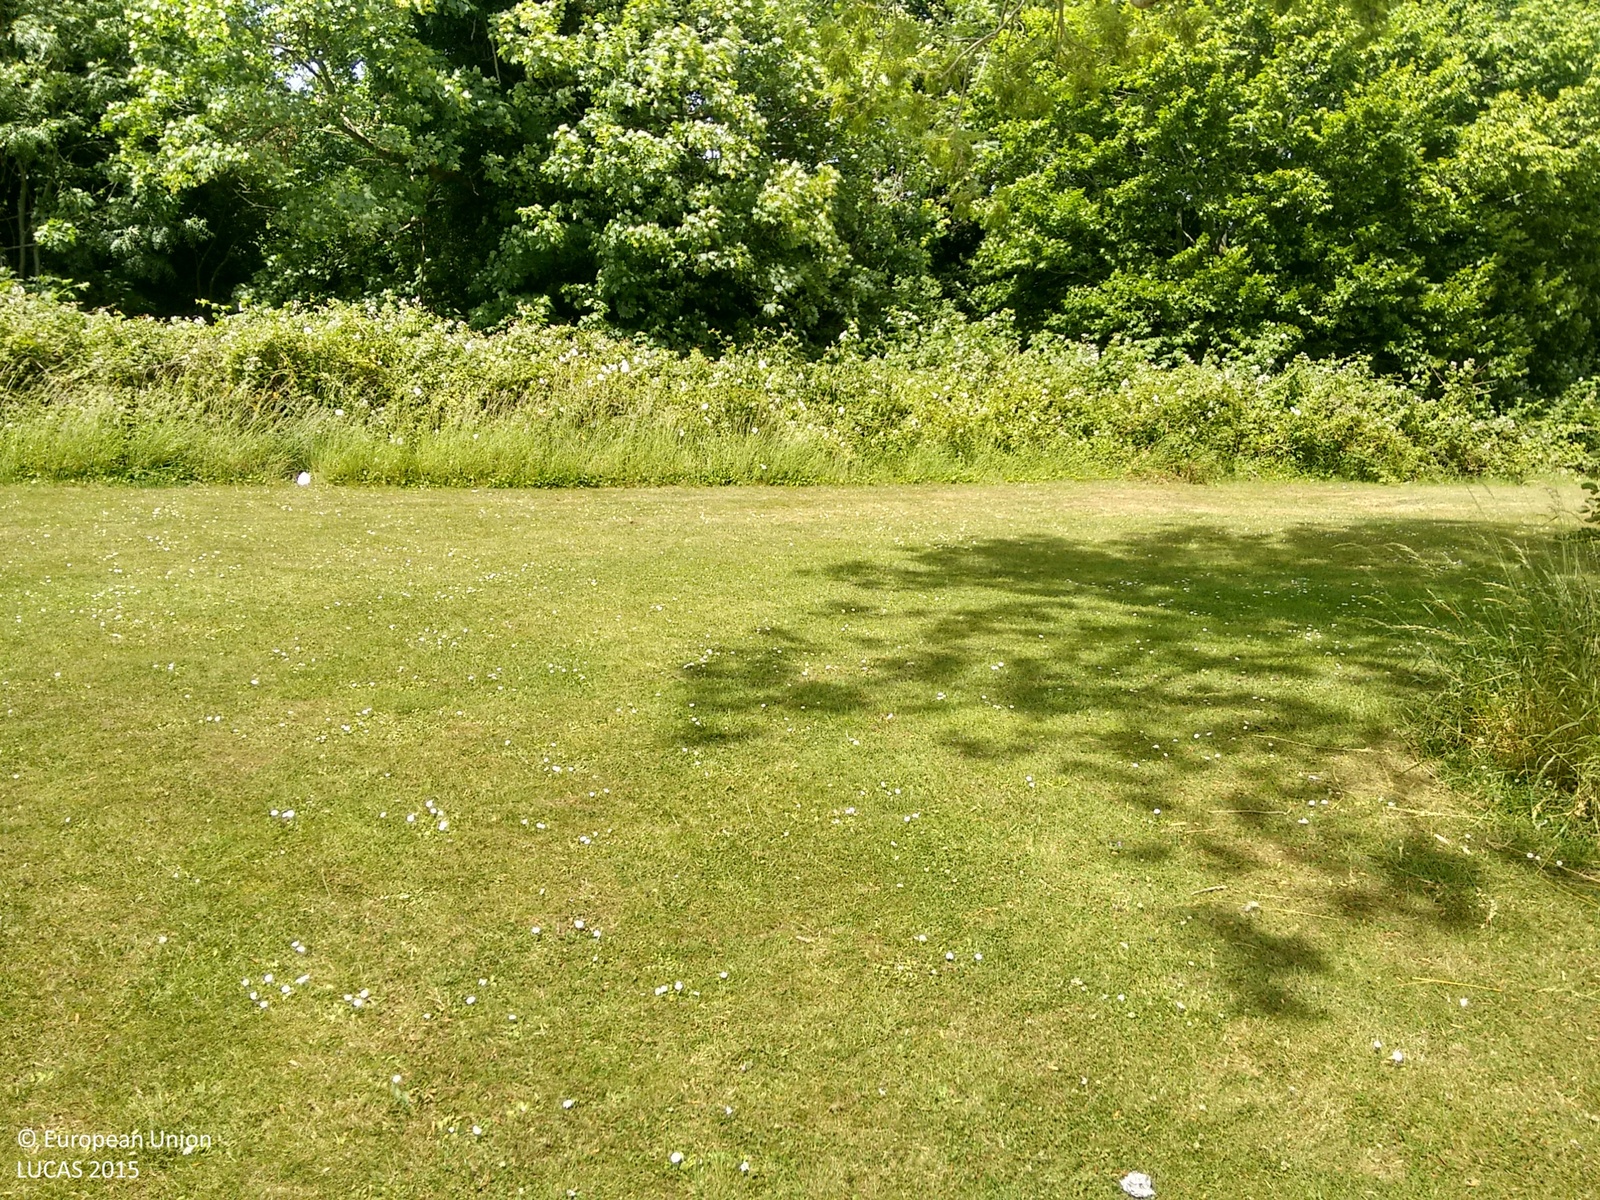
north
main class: Grassland
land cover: Grassland with sparse tree/shrub cover
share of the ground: > 75 %
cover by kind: herbaceous plants 85 %, shrubs 10 %, broadleaved forest trees 5 %
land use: Amenities, museums, leisure
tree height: > 5 m
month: June
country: GB
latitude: 50.8578
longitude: -0.1061
